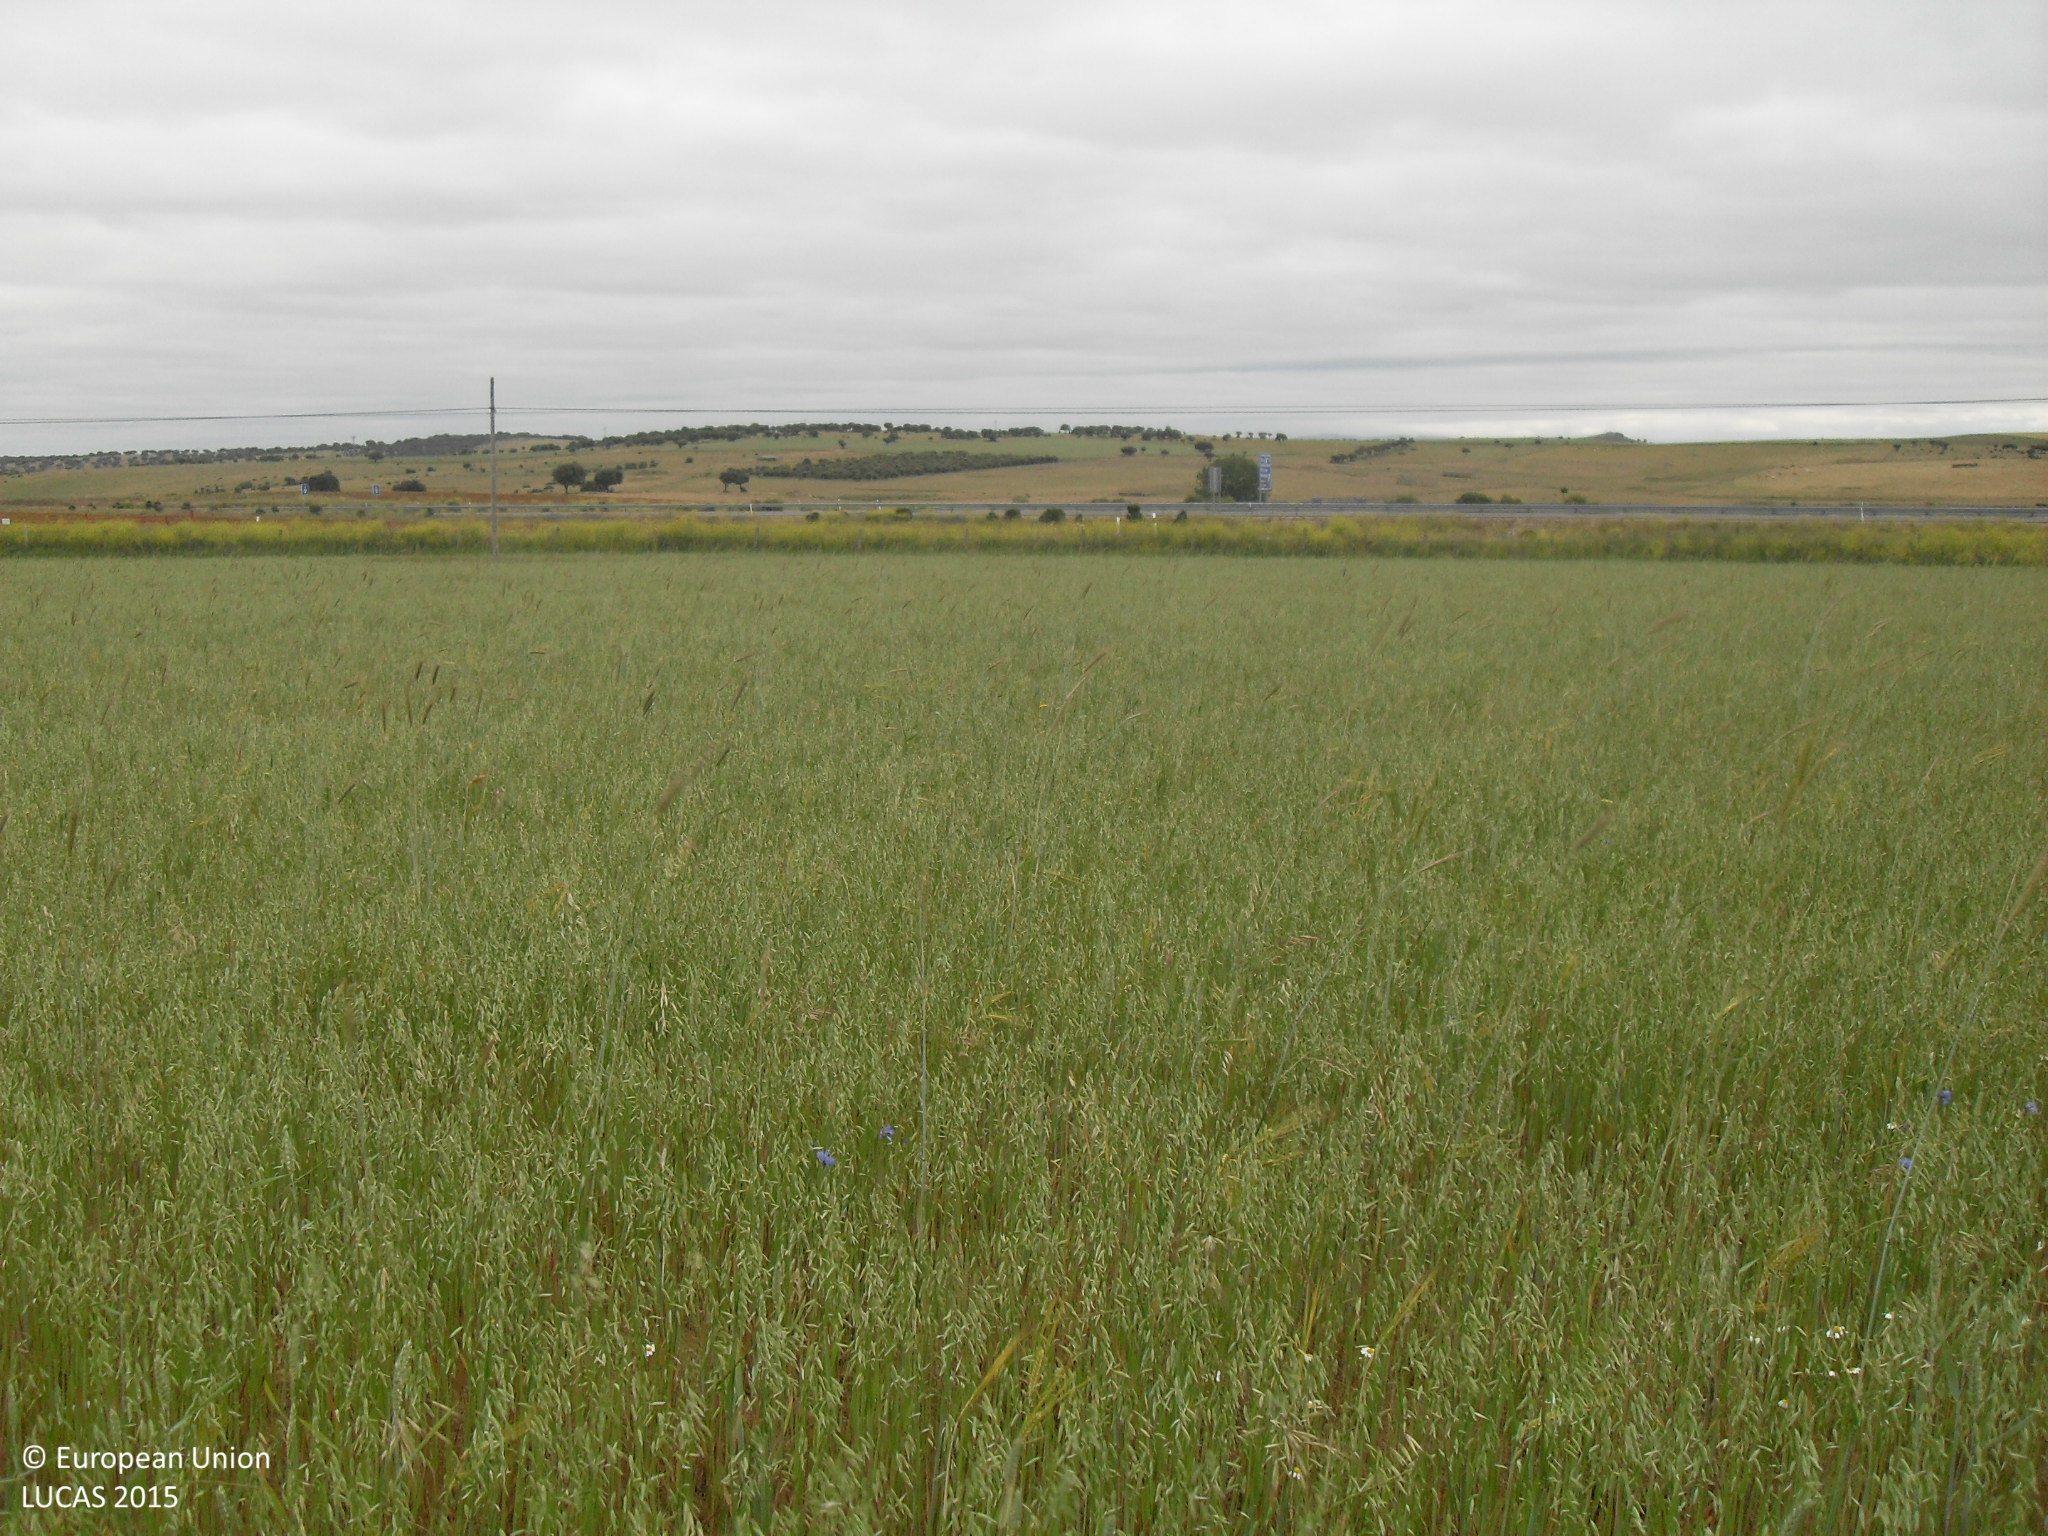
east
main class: Cropland
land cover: Oats
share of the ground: > 75 %
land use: Agriculture (excluding fallow land and kitchen gardens)
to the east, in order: Oats; Electric lines; Oats; Grass margins; Fences; Grass margins; Paved roads, cycling and walking lanes; Grass margins; Fences; Grass margins; Other bare soil; Fences; Tracks; Fences; Other bare soil; Fences; Grass margins; Paved roads, cycling and walking lanes
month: May
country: ES
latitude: 40.6610
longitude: -5.6260
